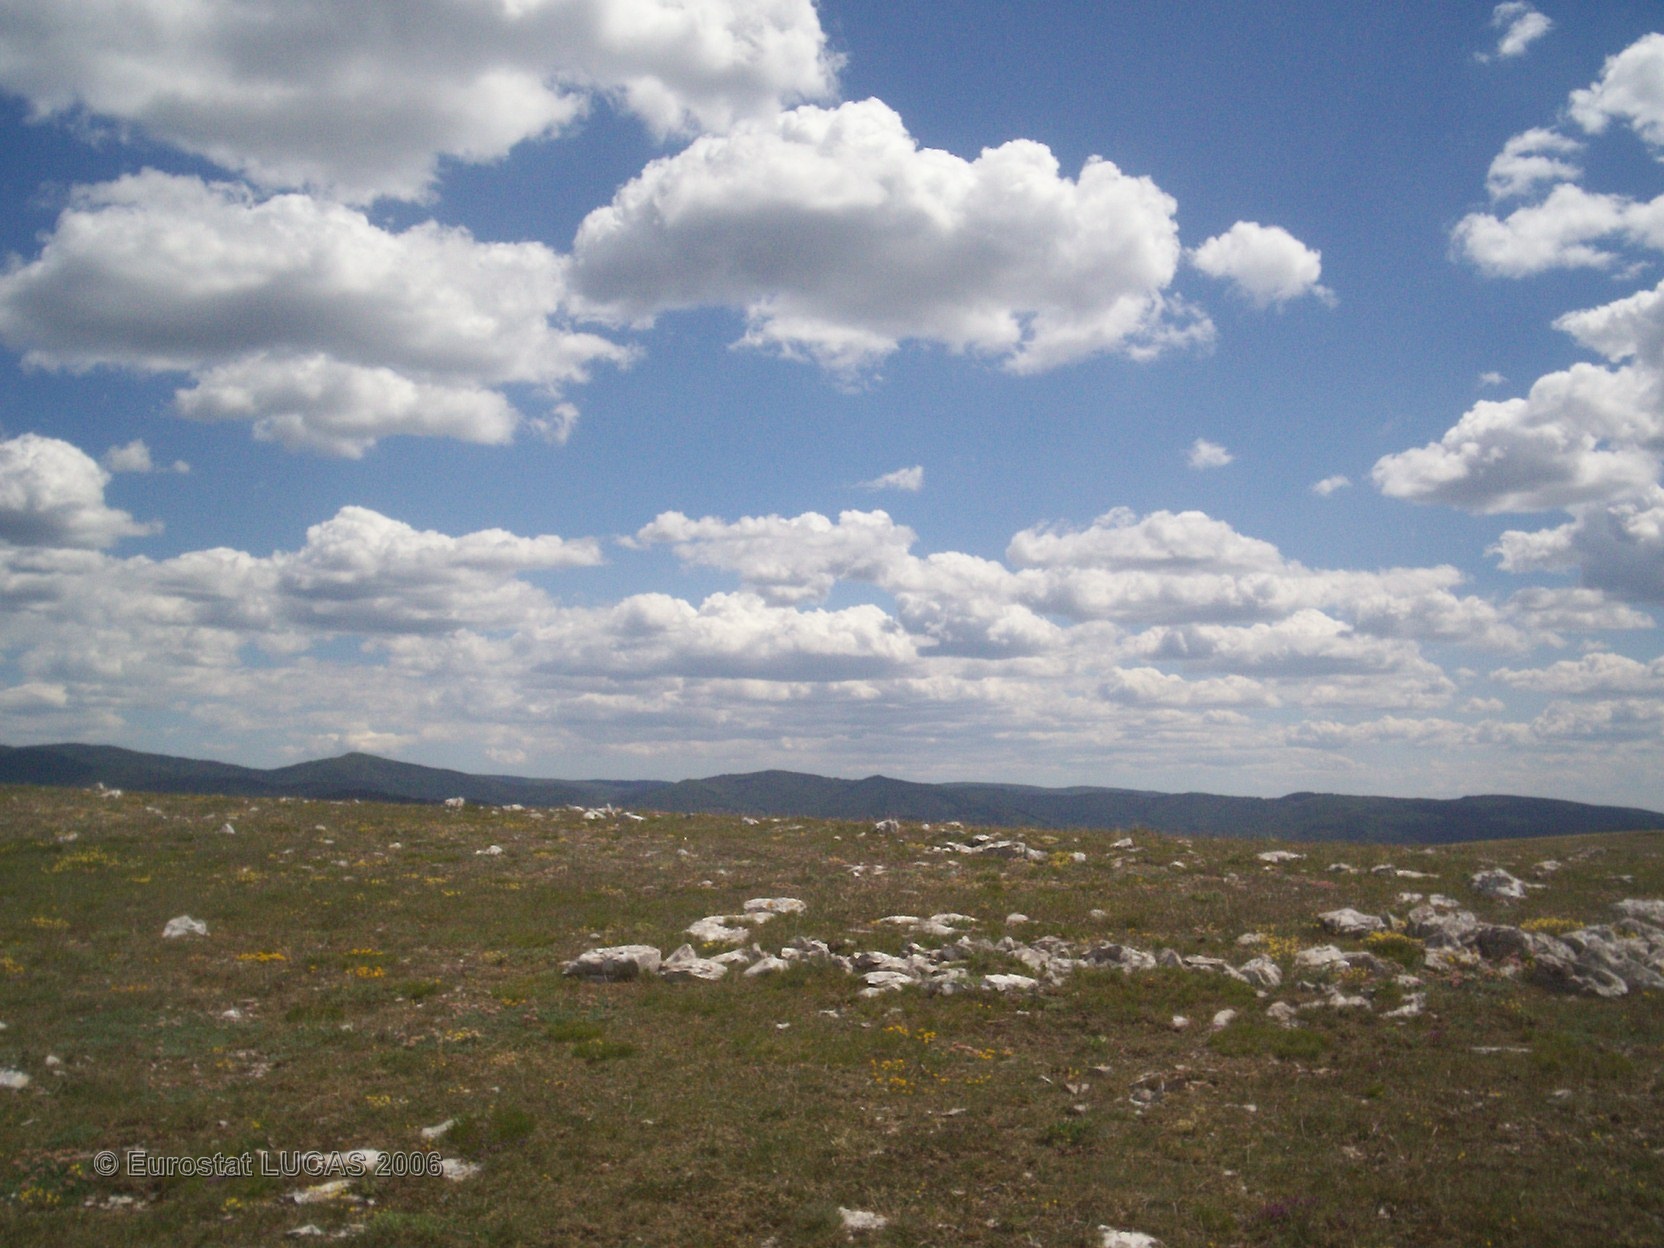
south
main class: Grassland
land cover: Grassland without tree/shrub cover
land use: Agriculture (excluding fallow land and kitchen gardens)
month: June
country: FR
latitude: 44.2165
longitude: 3.4601
